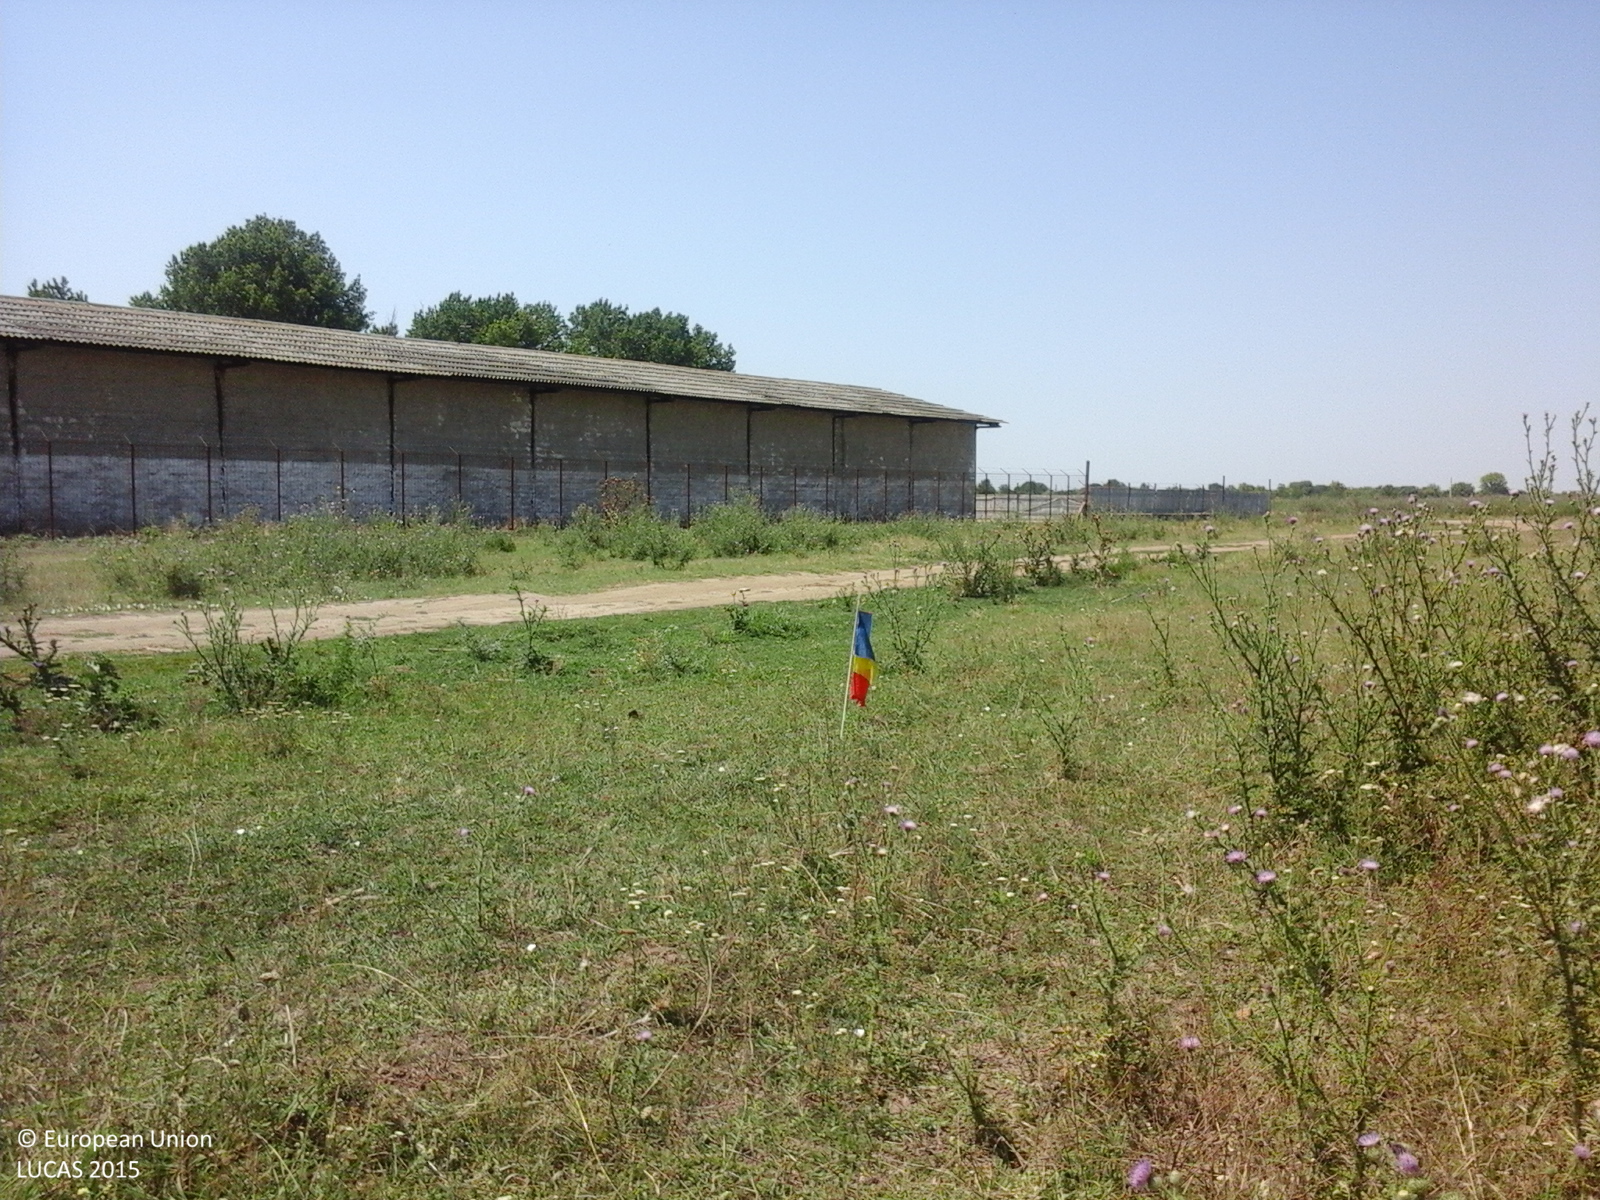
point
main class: Grassland
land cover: Grassland without tree/shrub cover
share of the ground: > 75 %
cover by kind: herbaceous plants 100 %
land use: Agriculture (excluding fallow land and kitchen gardens)
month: July
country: RO
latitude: 44.2301
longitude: 27.5043
